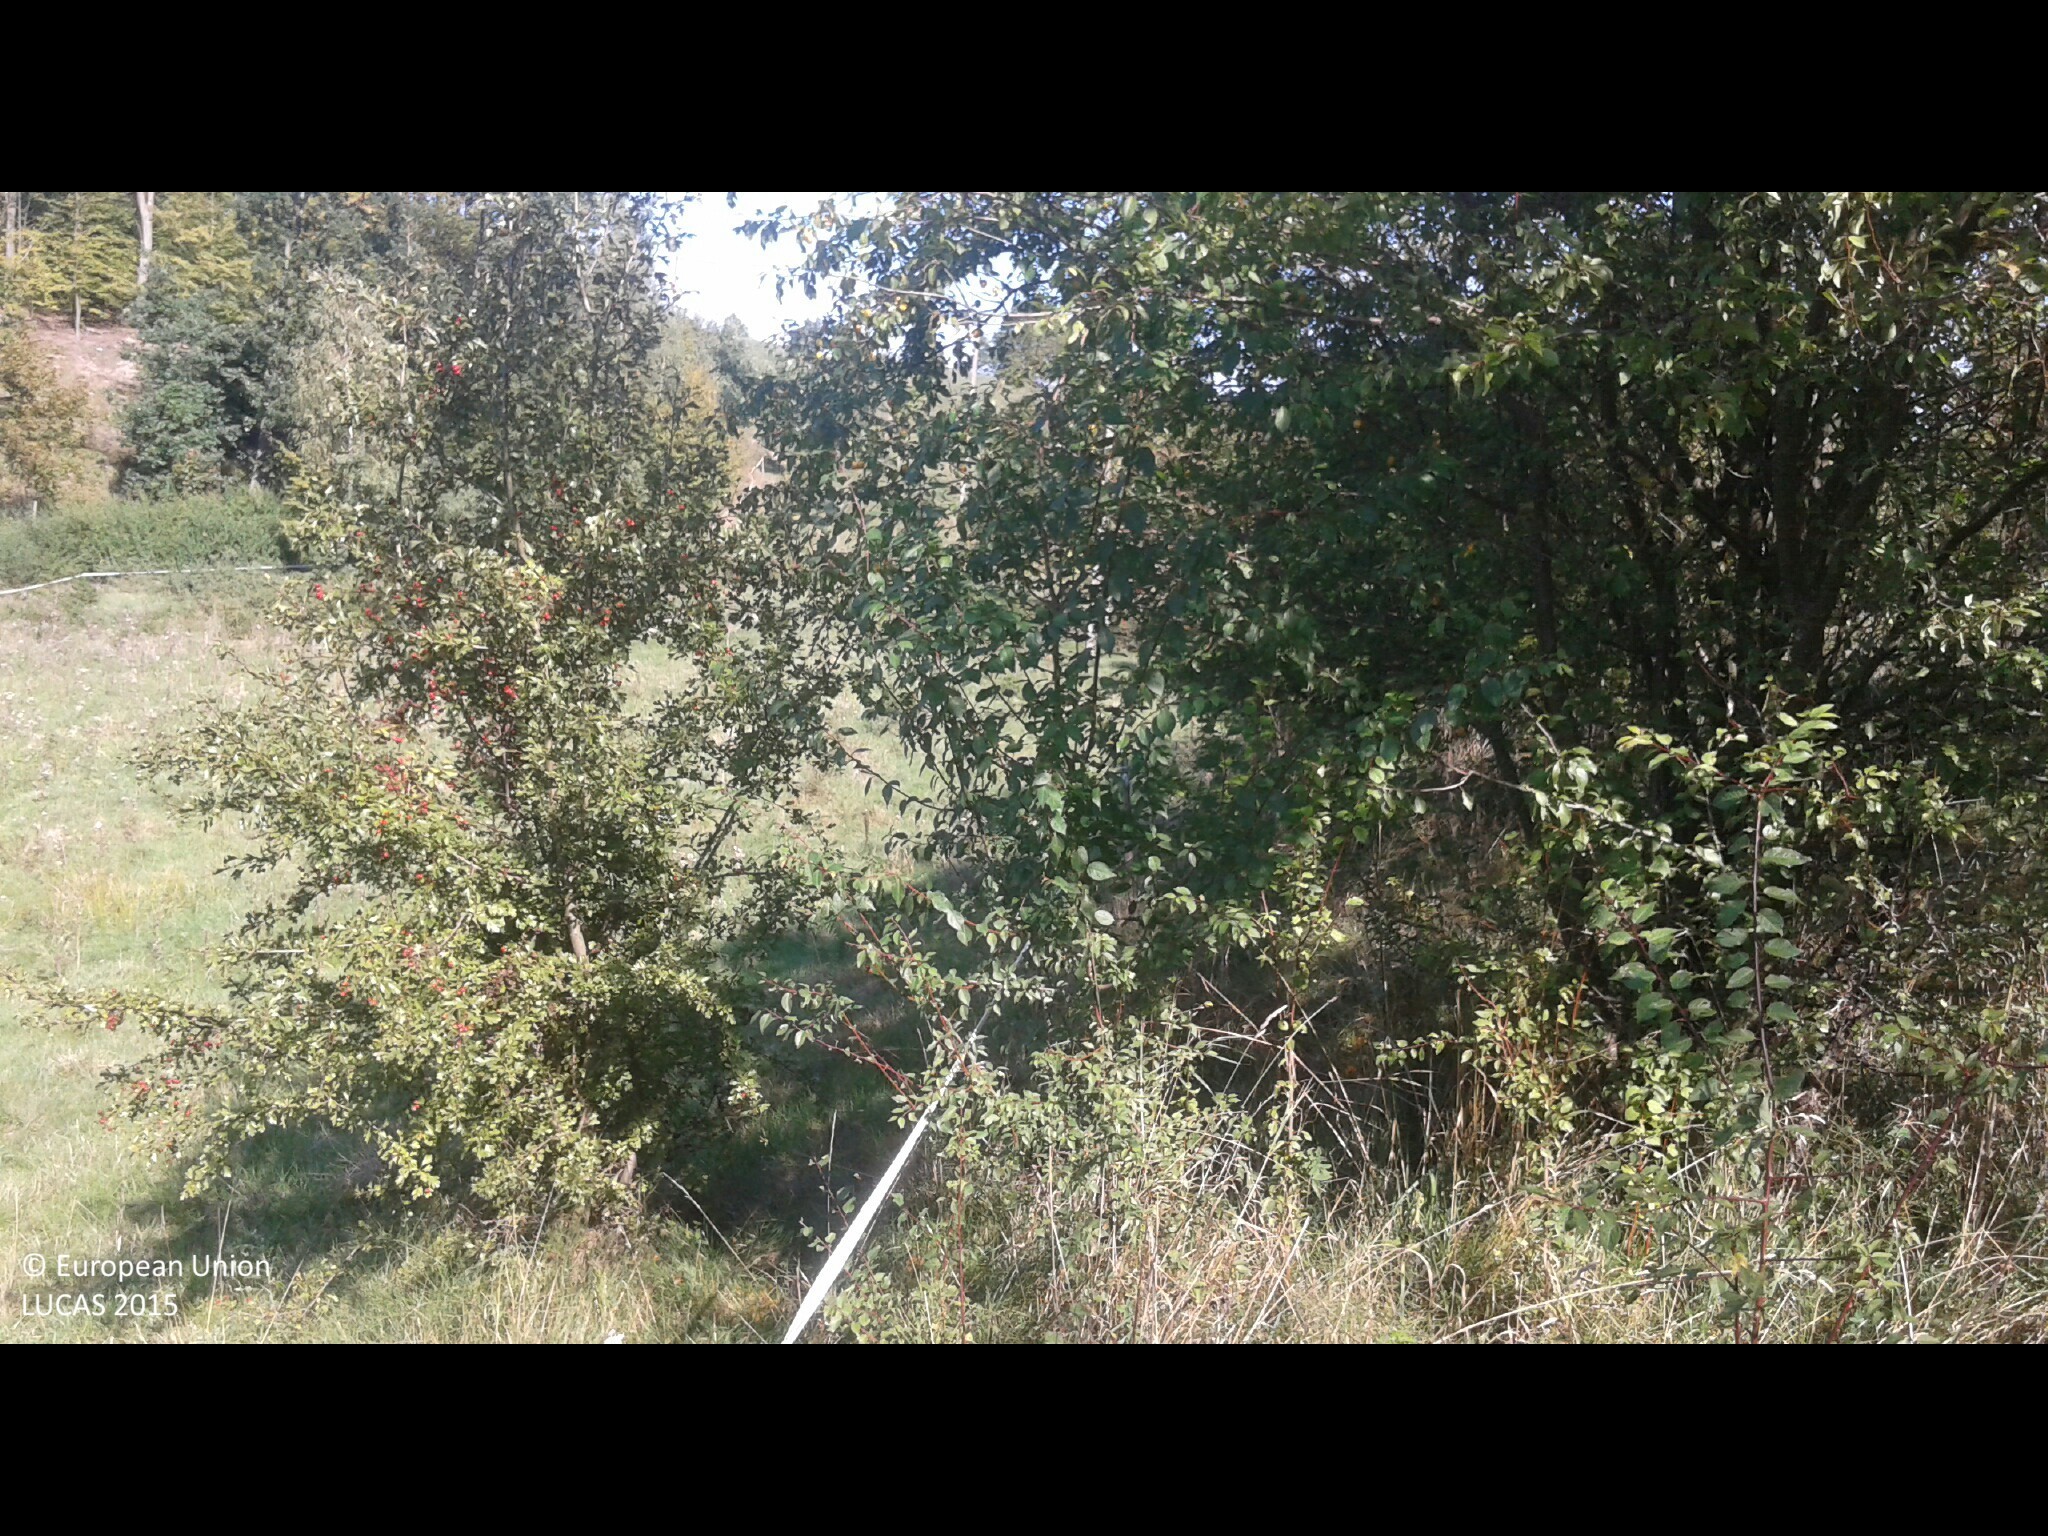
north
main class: Cropland
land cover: Cherry fruit
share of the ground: 25 - 50 %
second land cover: Grassland without tree/shrub cover
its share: > 75 %
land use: Agriculture (excluding fallow land and kitchen gardens)
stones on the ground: < 10 %
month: September
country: PL
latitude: 53.8554
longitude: 20.2350
